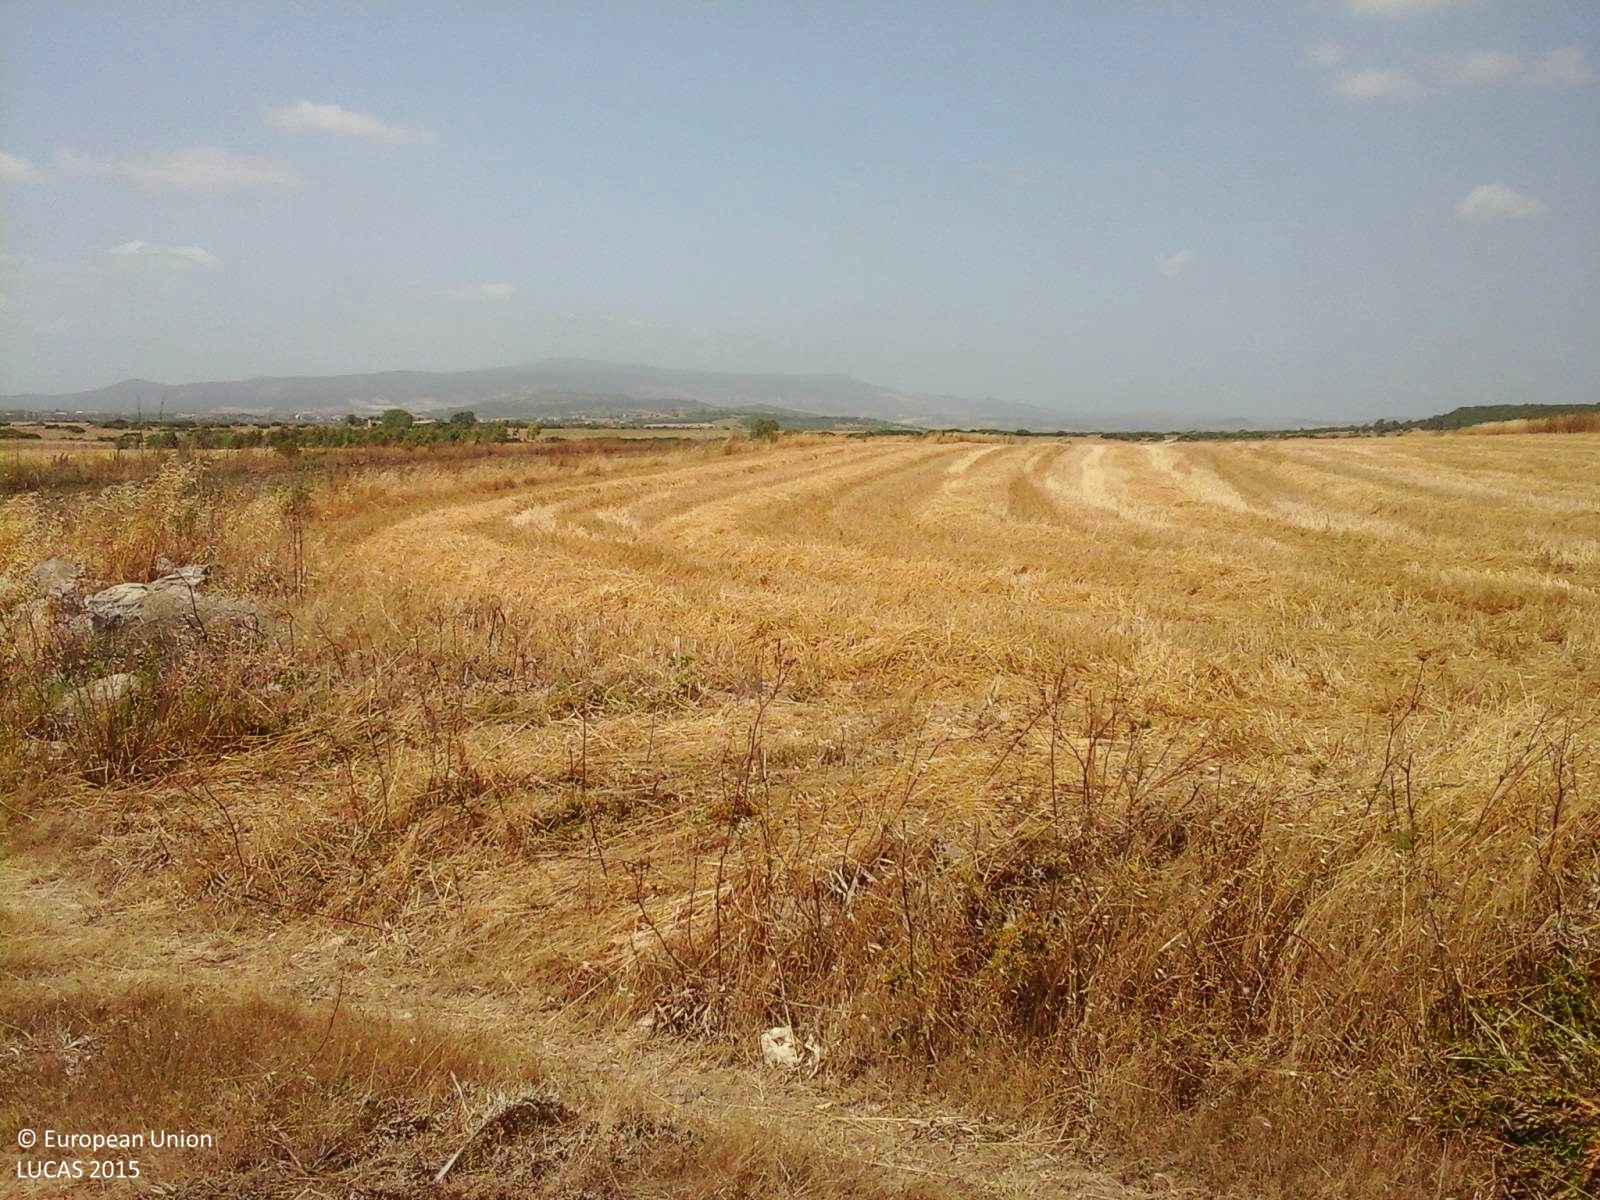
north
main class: Cropland
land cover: Oats
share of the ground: 10 - 25 %
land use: Agriculture (excluding fallow land and kitchen gardens)
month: July
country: IT
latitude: 39.6441
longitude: 8.7835
